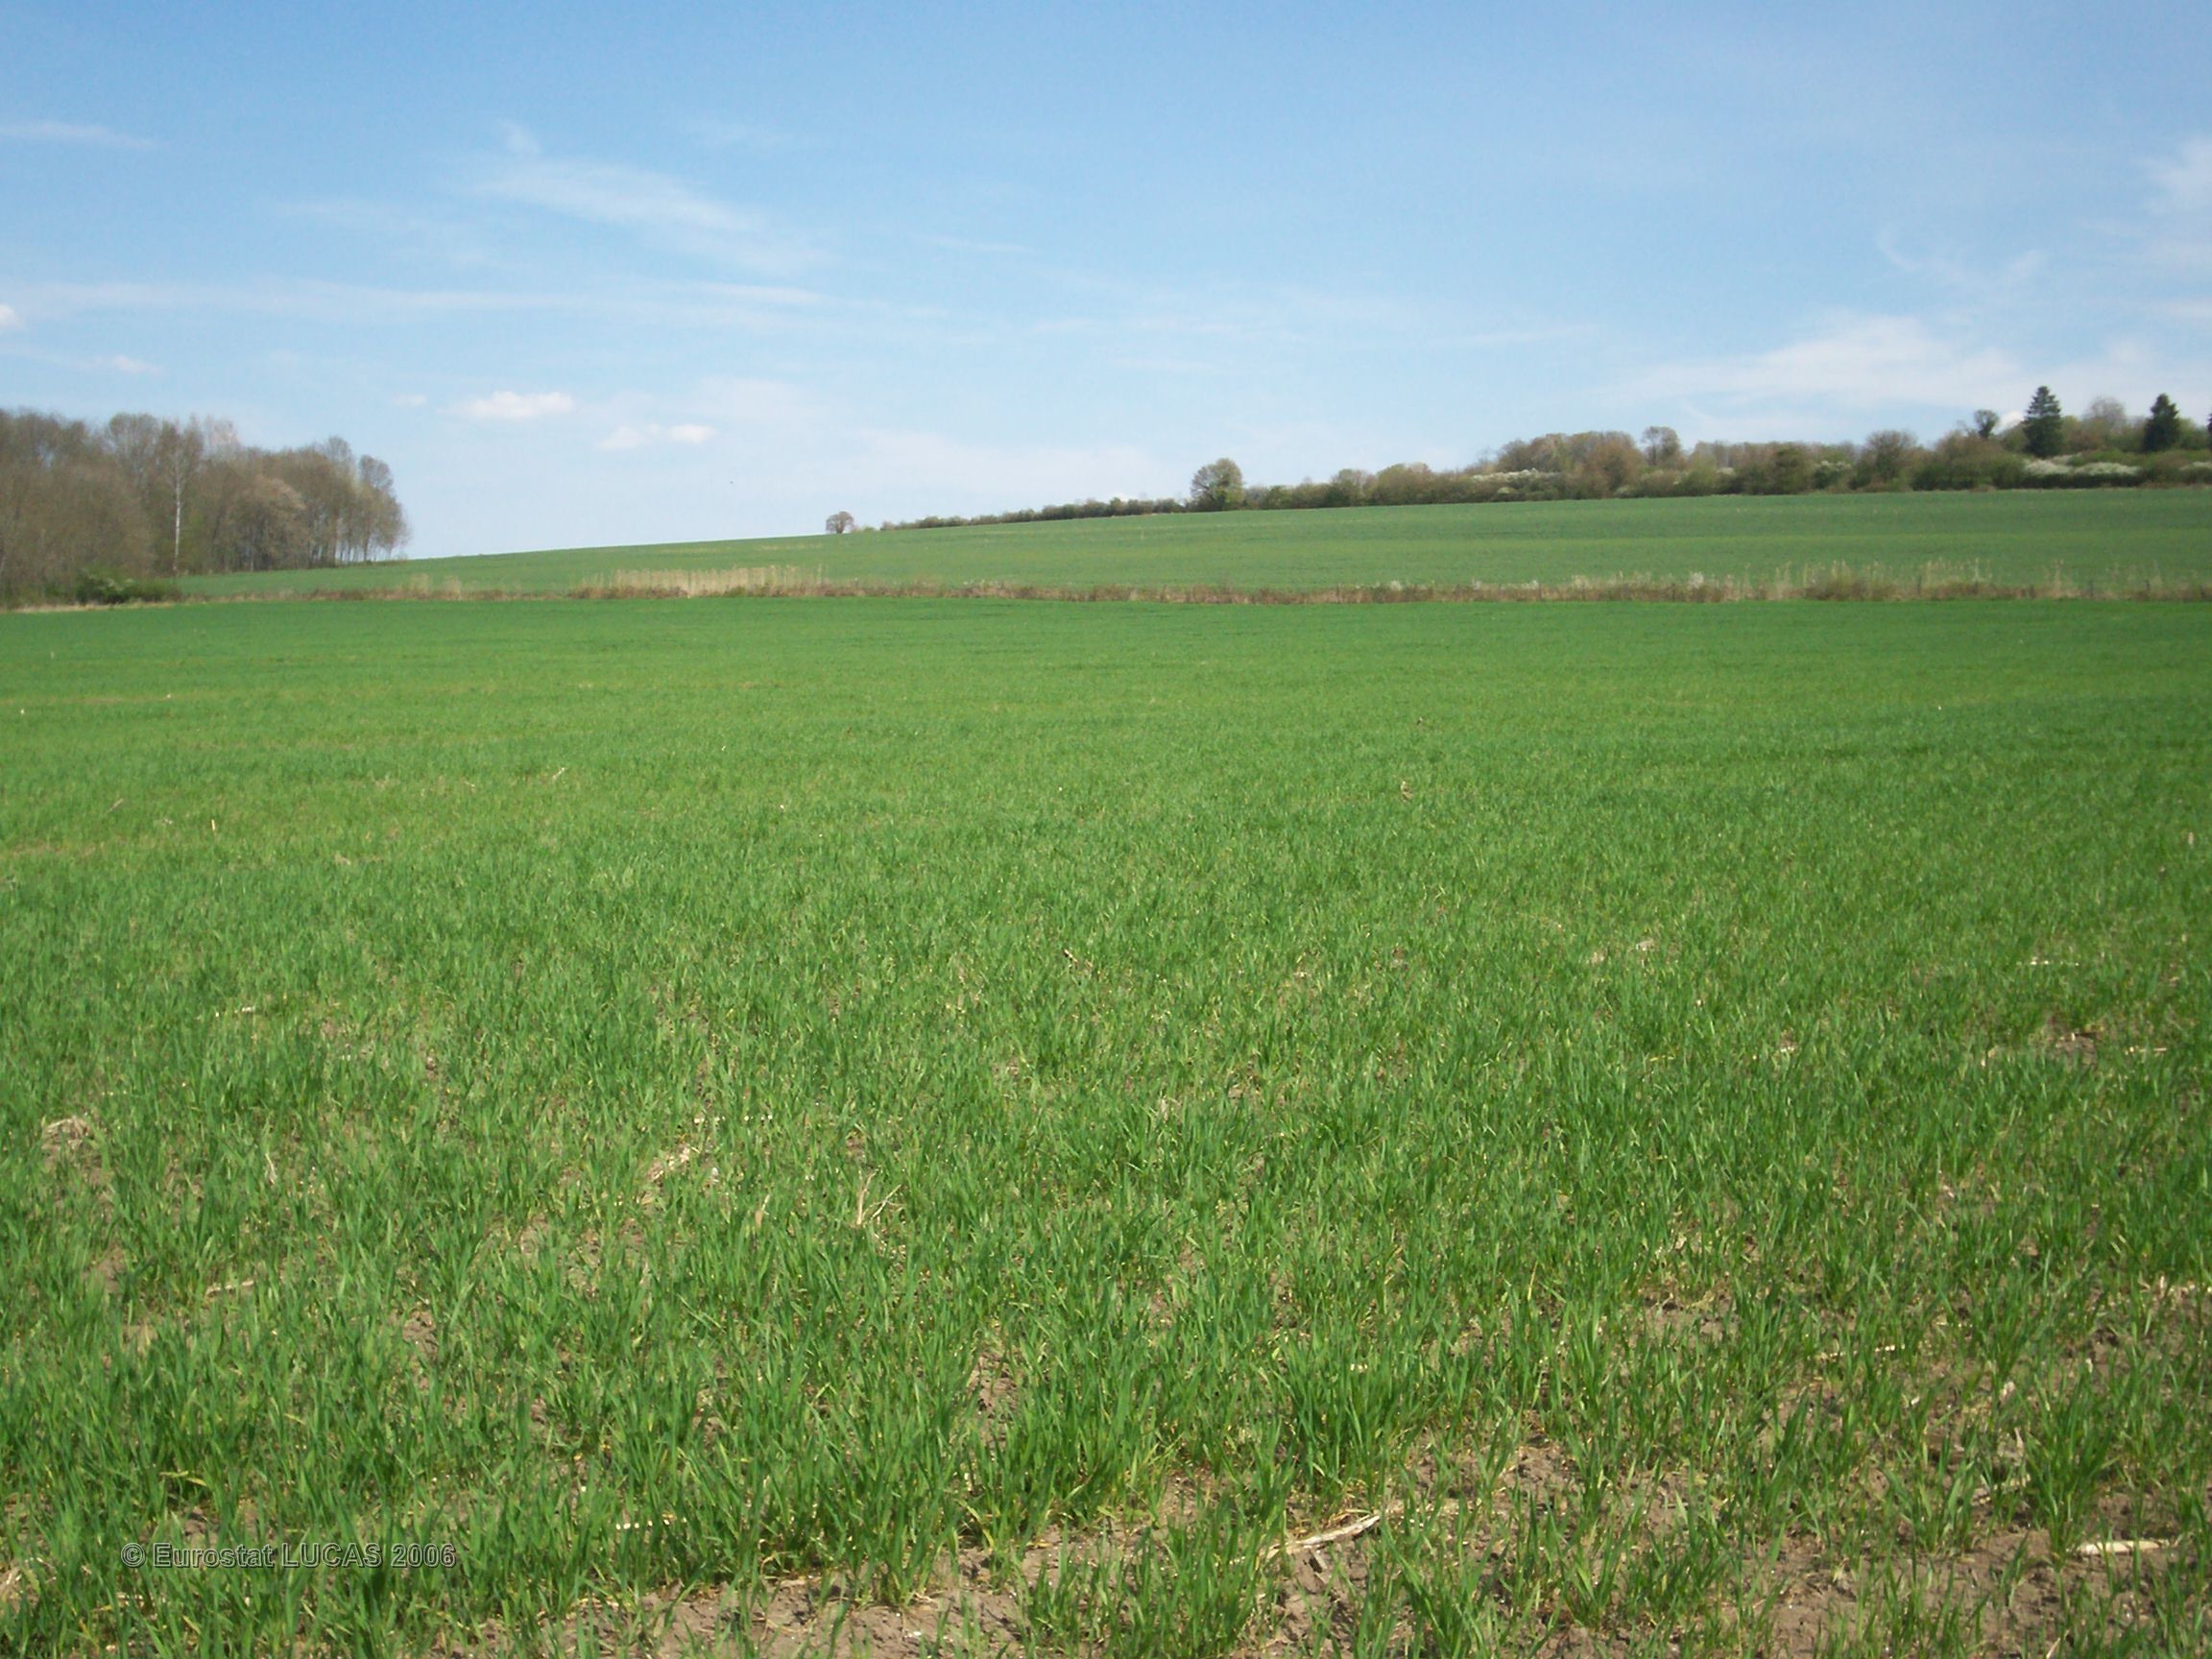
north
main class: Cropland
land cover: Common wheat
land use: Agriculture (excluding fallow land and kitchen gardens)
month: April
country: FR
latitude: 47.9367
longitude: 6.0518
